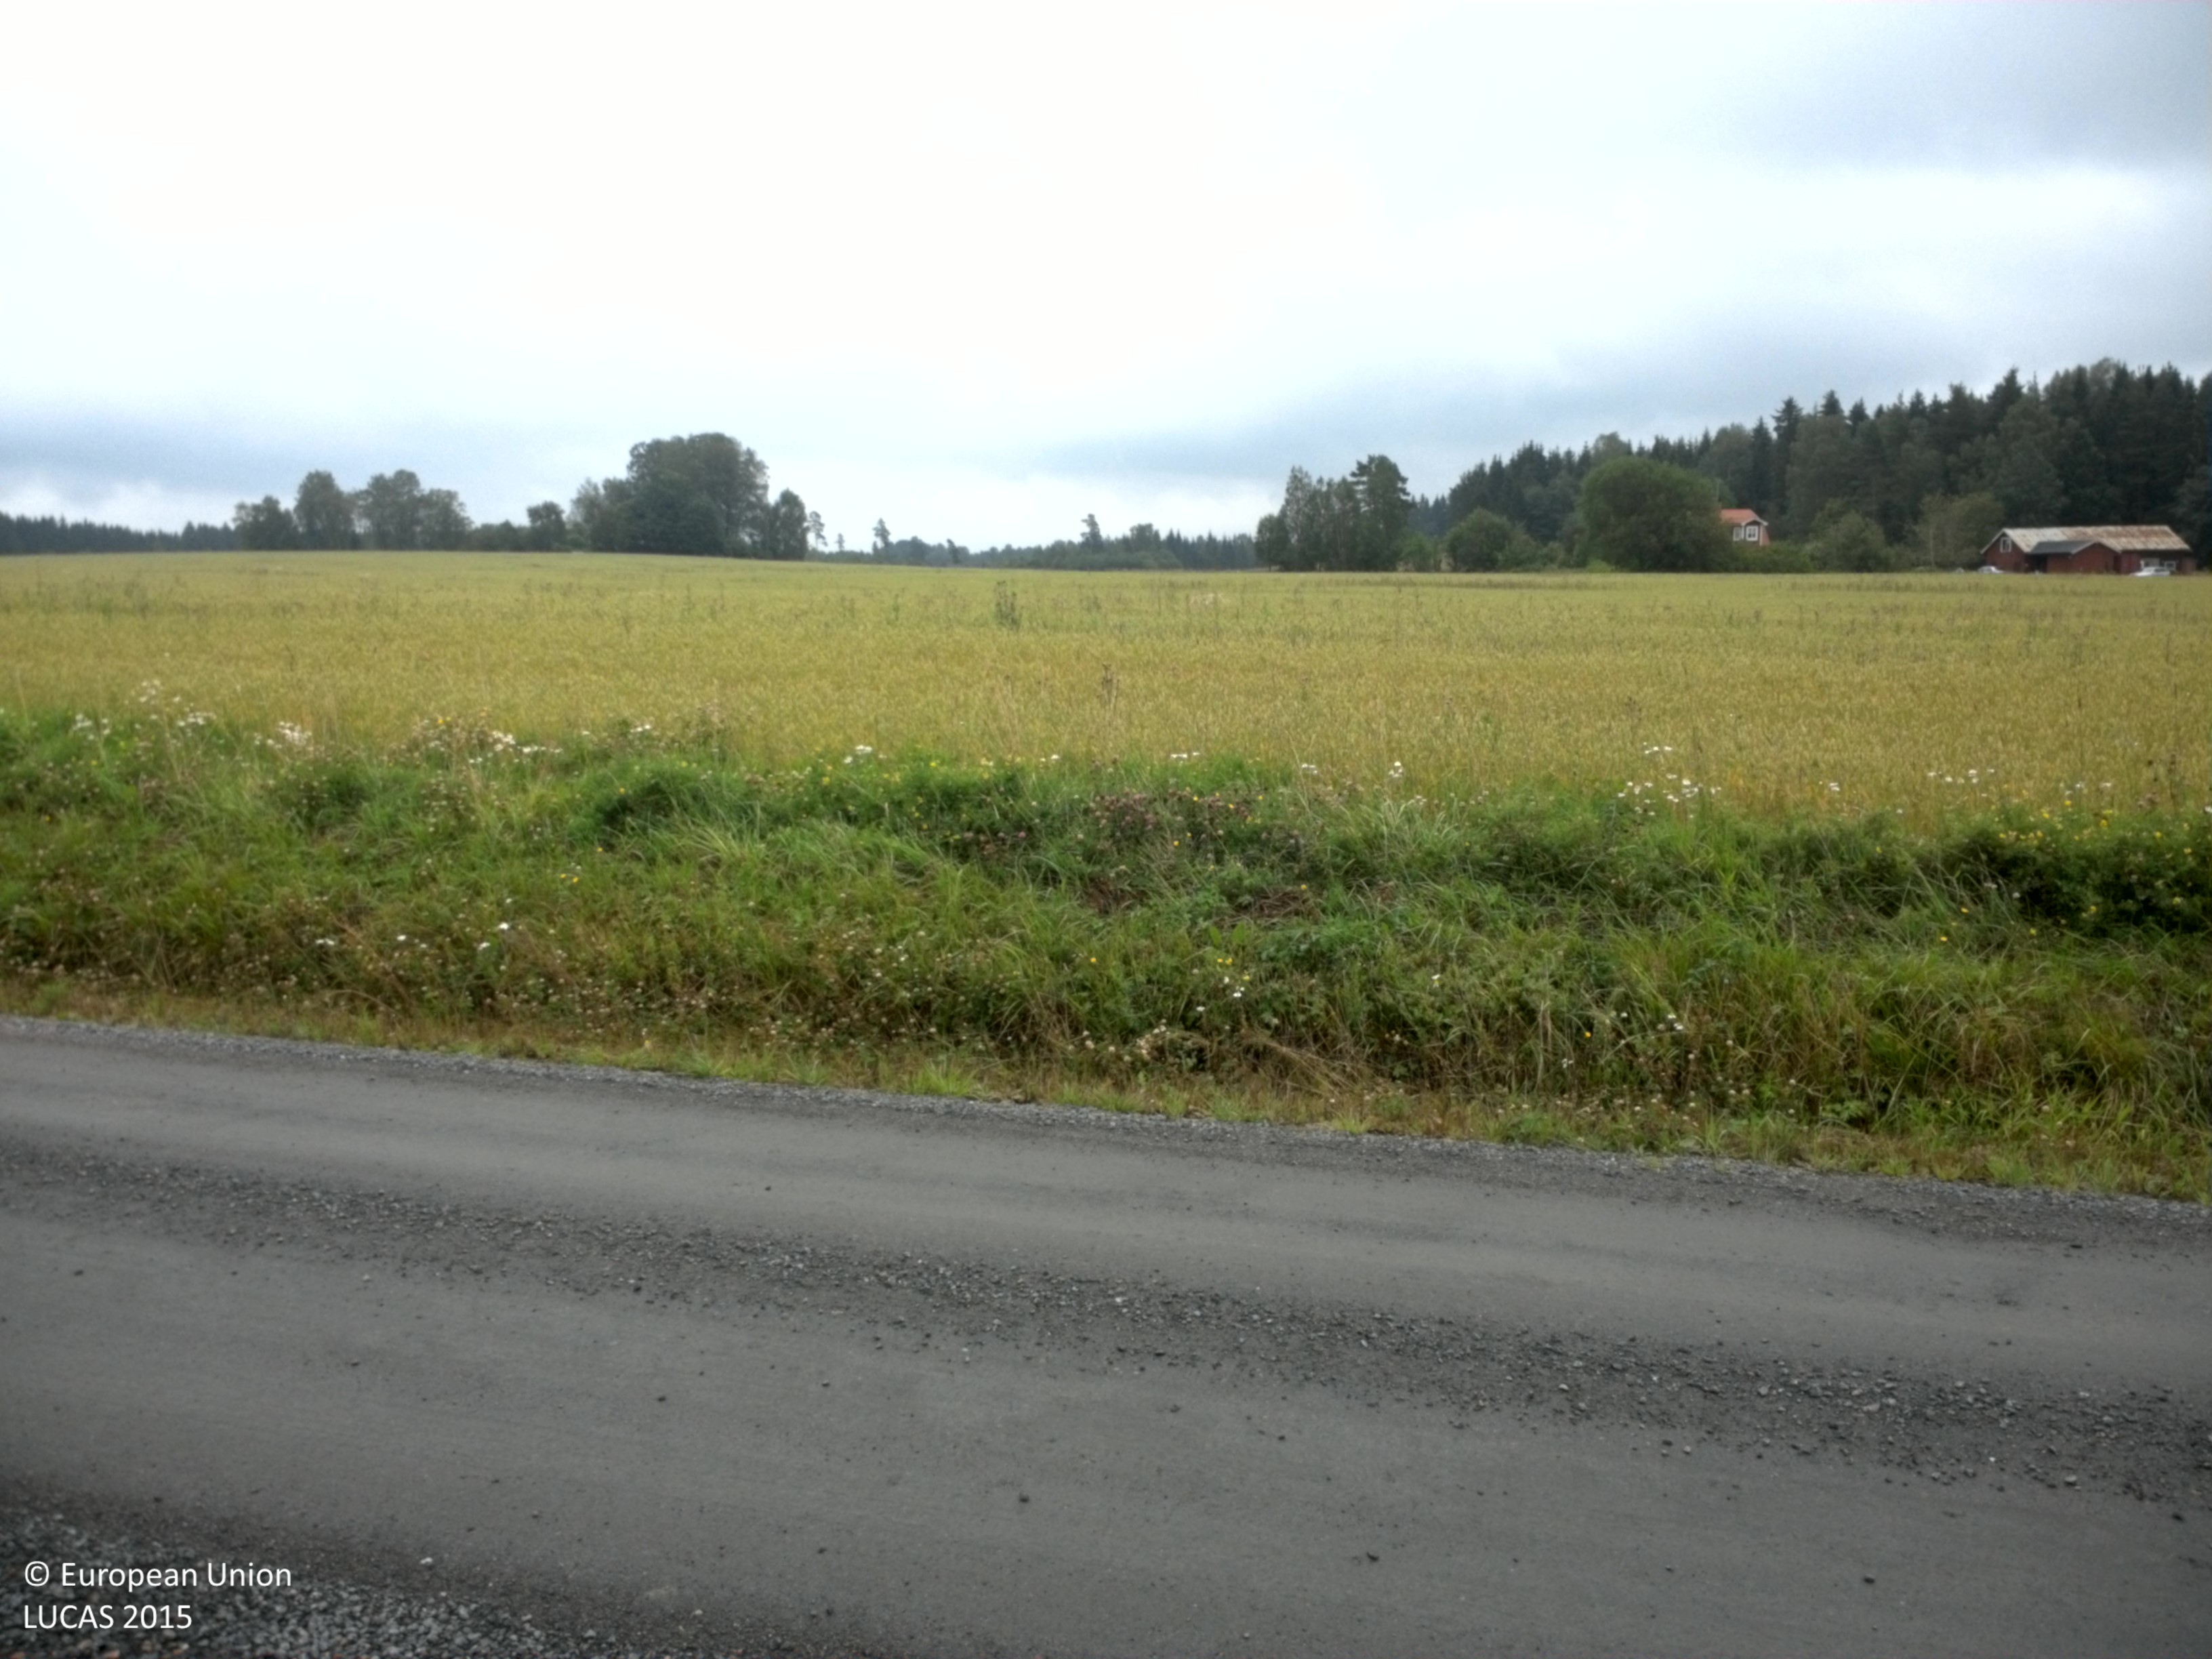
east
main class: Cropland
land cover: Common wheat
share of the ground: > 75 %
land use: Agriculture (excluding fallow land and kitchen gardens)
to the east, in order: Common wheat; Grass margins; Paved roads, cycling and walking lanes; Ditches and canals; Grass margins; Common wheat
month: August
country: SE
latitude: 59.4945
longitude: 13.2596
